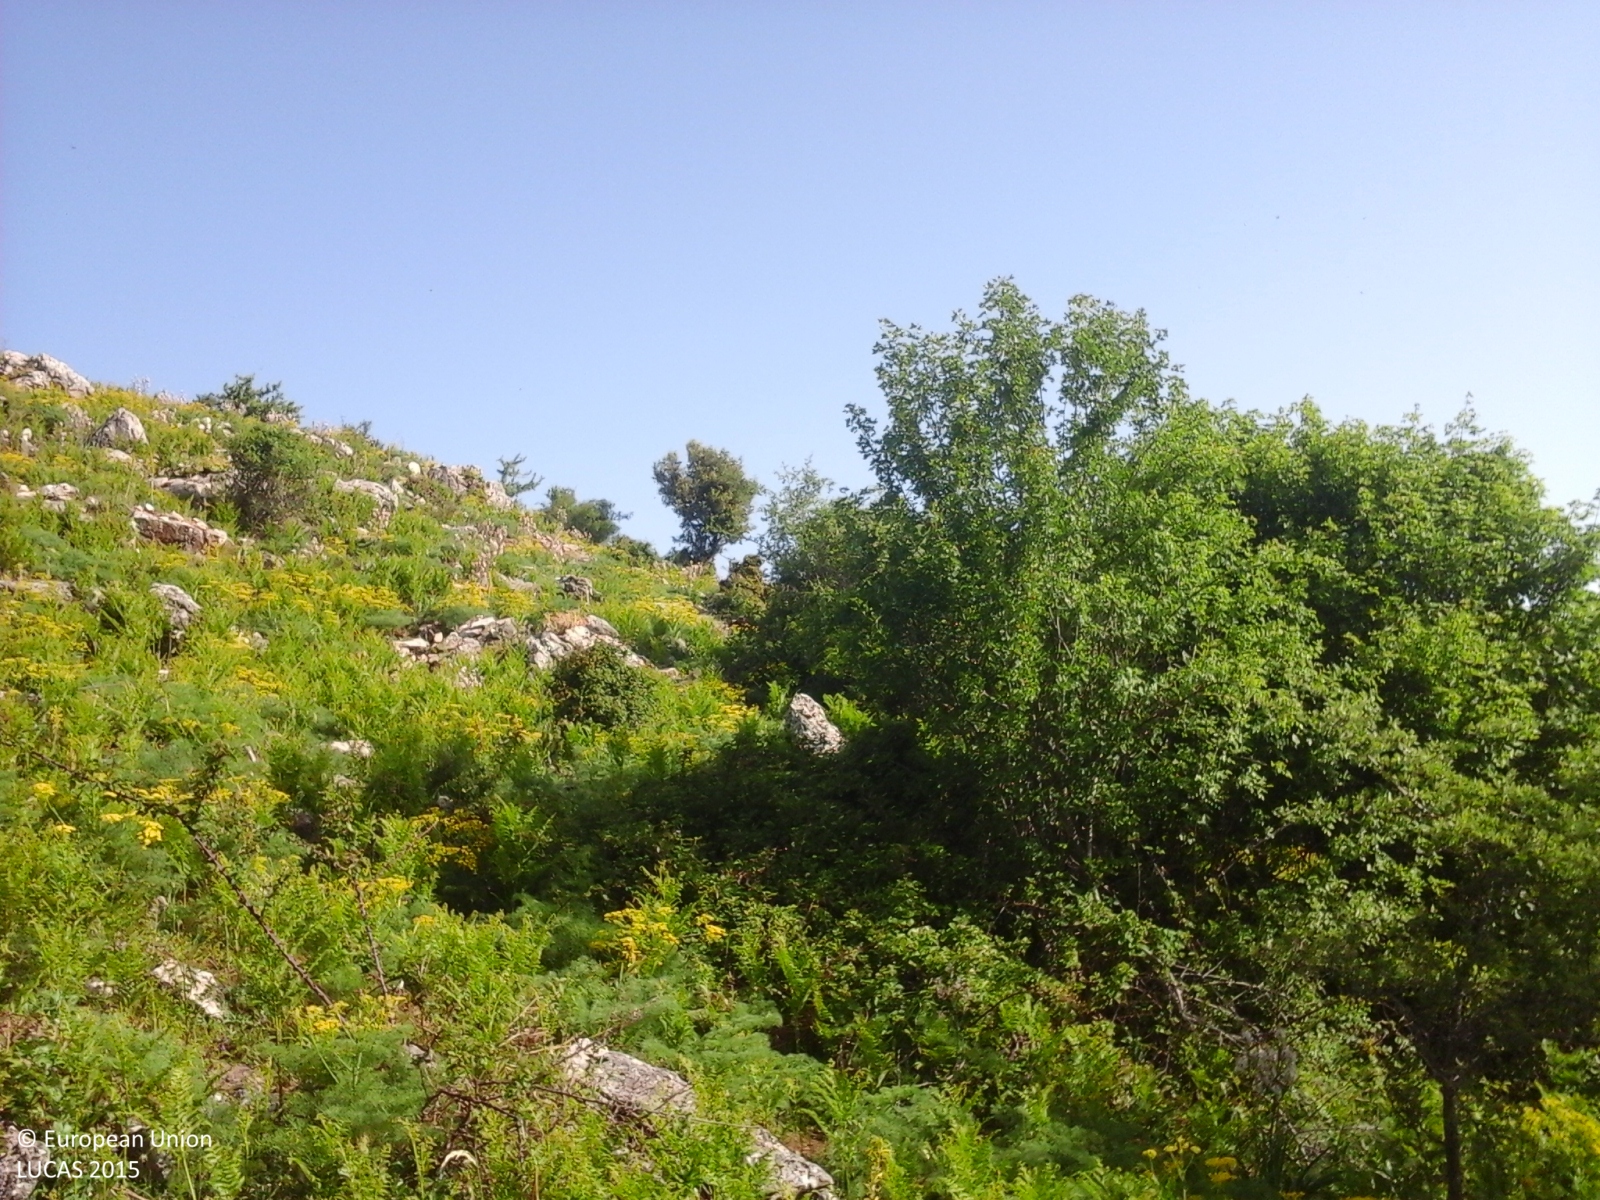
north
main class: Grassland
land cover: Grassland with sparse tree/shrub cover
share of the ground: > 75 %
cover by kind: herbaceous plants 70 %, consolidated bare surface 15 %, shrubs 10 %, broadleaved forest trees 5 %
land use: Agriculture (excluding fallow land and kitchen gardens)
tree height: < 5 m
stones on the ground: 25 - 50 %
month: May
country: IT
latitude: 37.8611
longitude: 14.0519
